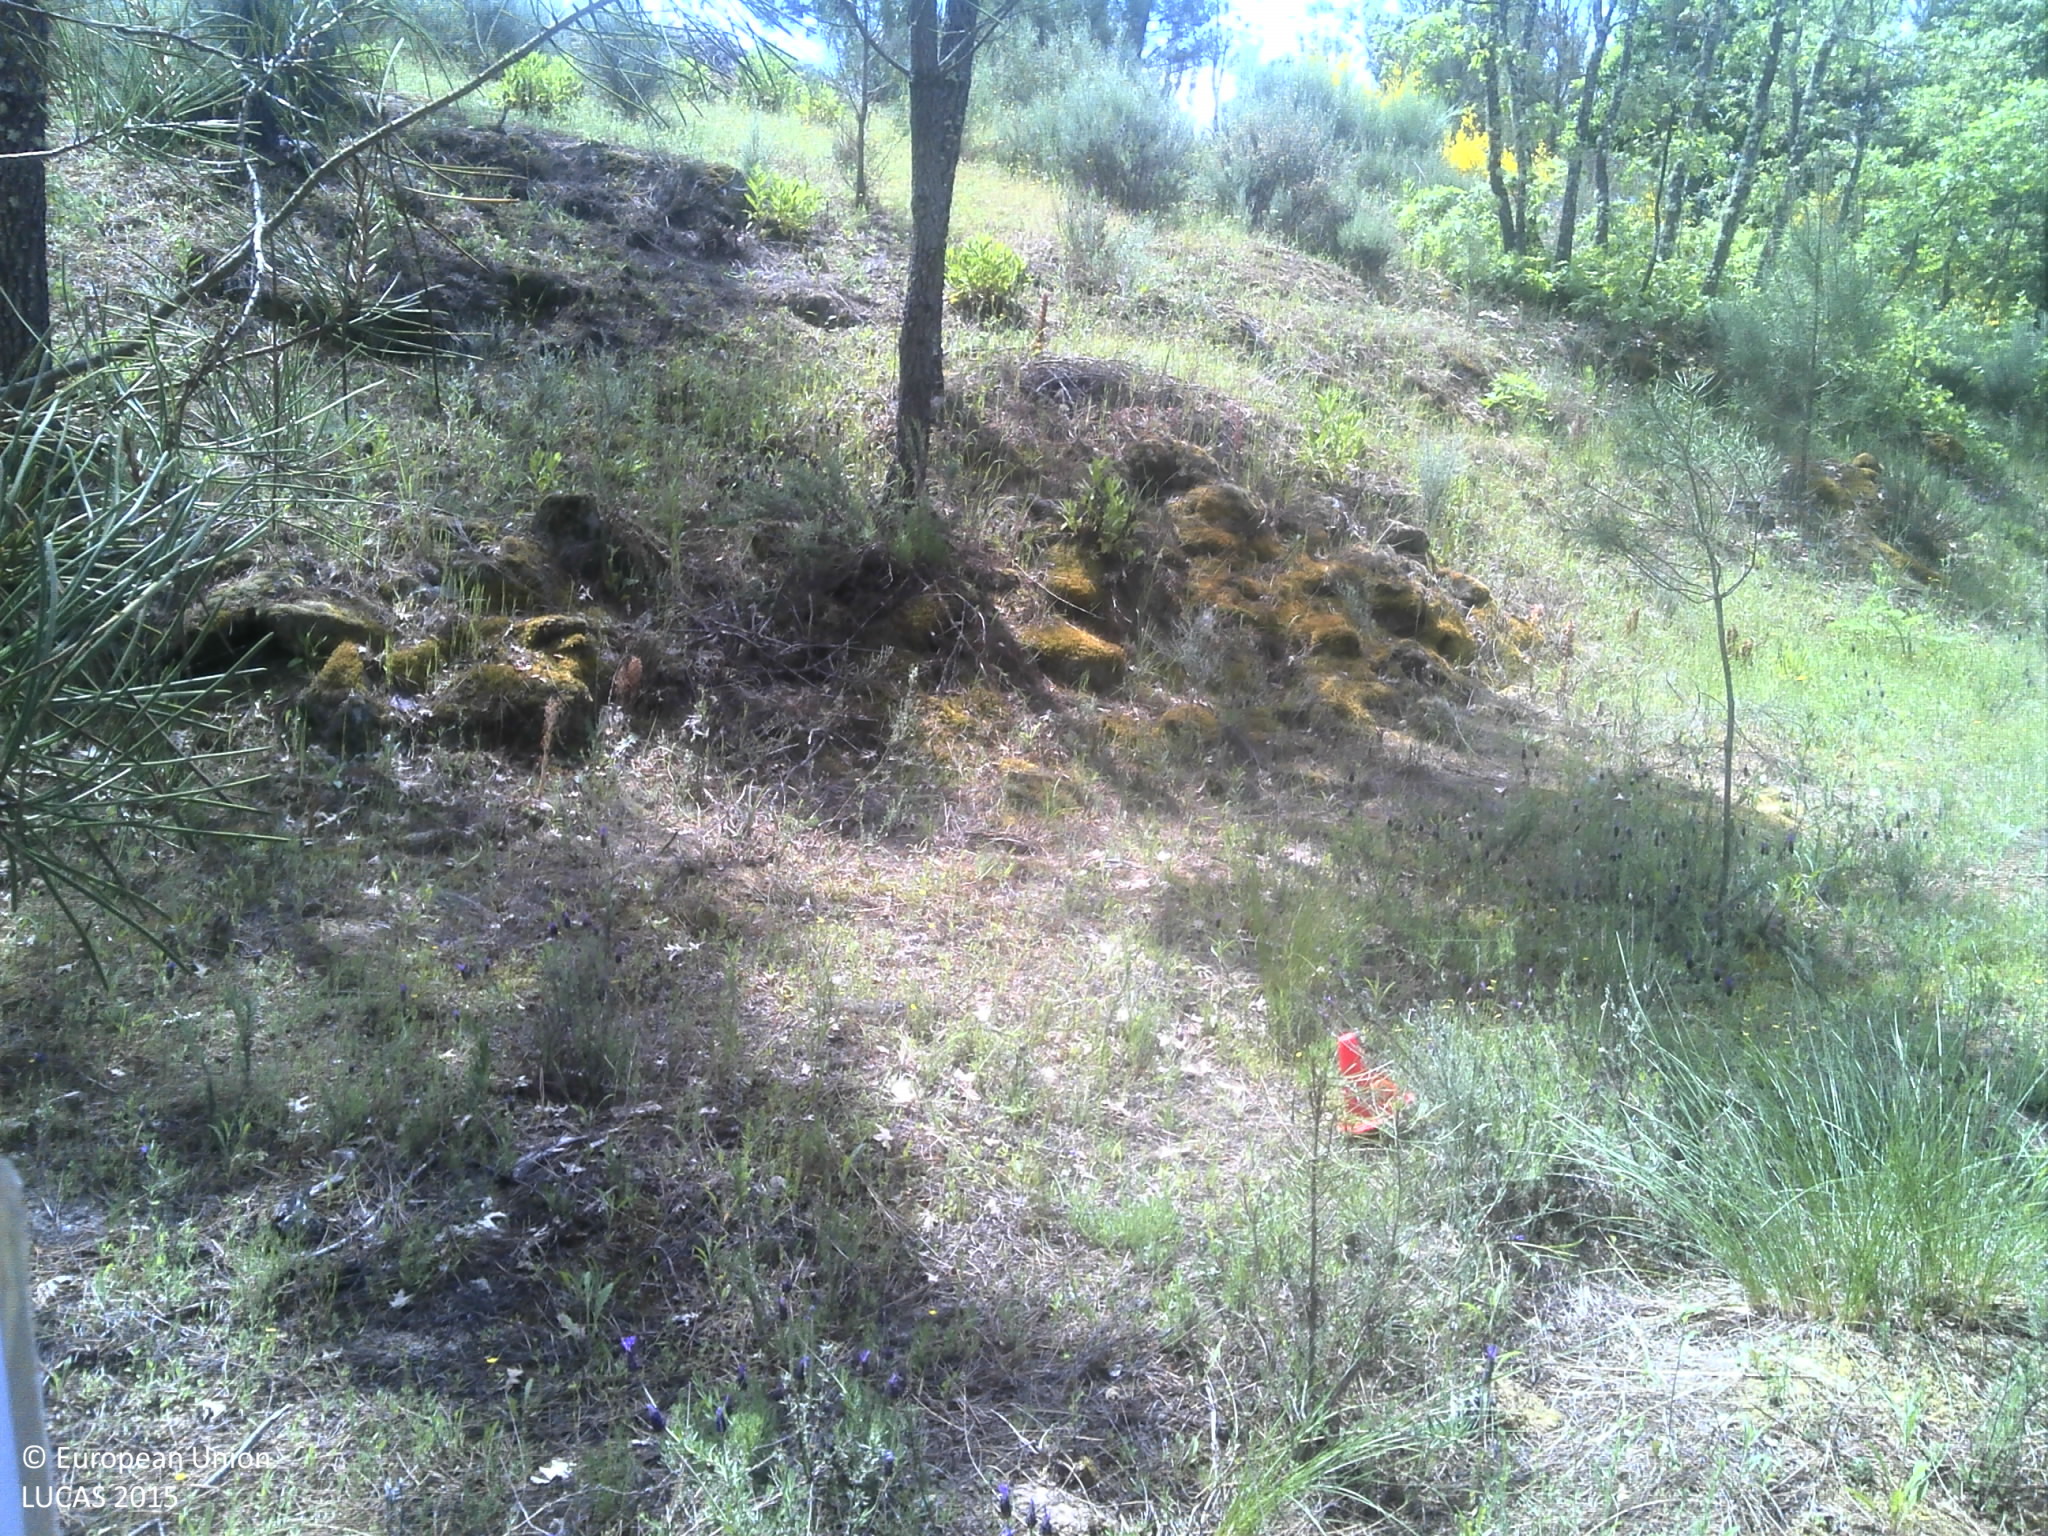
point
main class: Woodland
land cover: Pine dominated coniferous woodland
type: coniferous forest of the mediterranean region
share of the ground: 25 - 50 %
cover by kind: coniferous forest trees 50 %, shrubs 20 %, herbaceous plants 15 %, unconsolidated bare surface 15 %
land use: Forestry
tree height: > 5 m
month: May
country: PT
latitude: 40.7143
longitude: -7.4797
